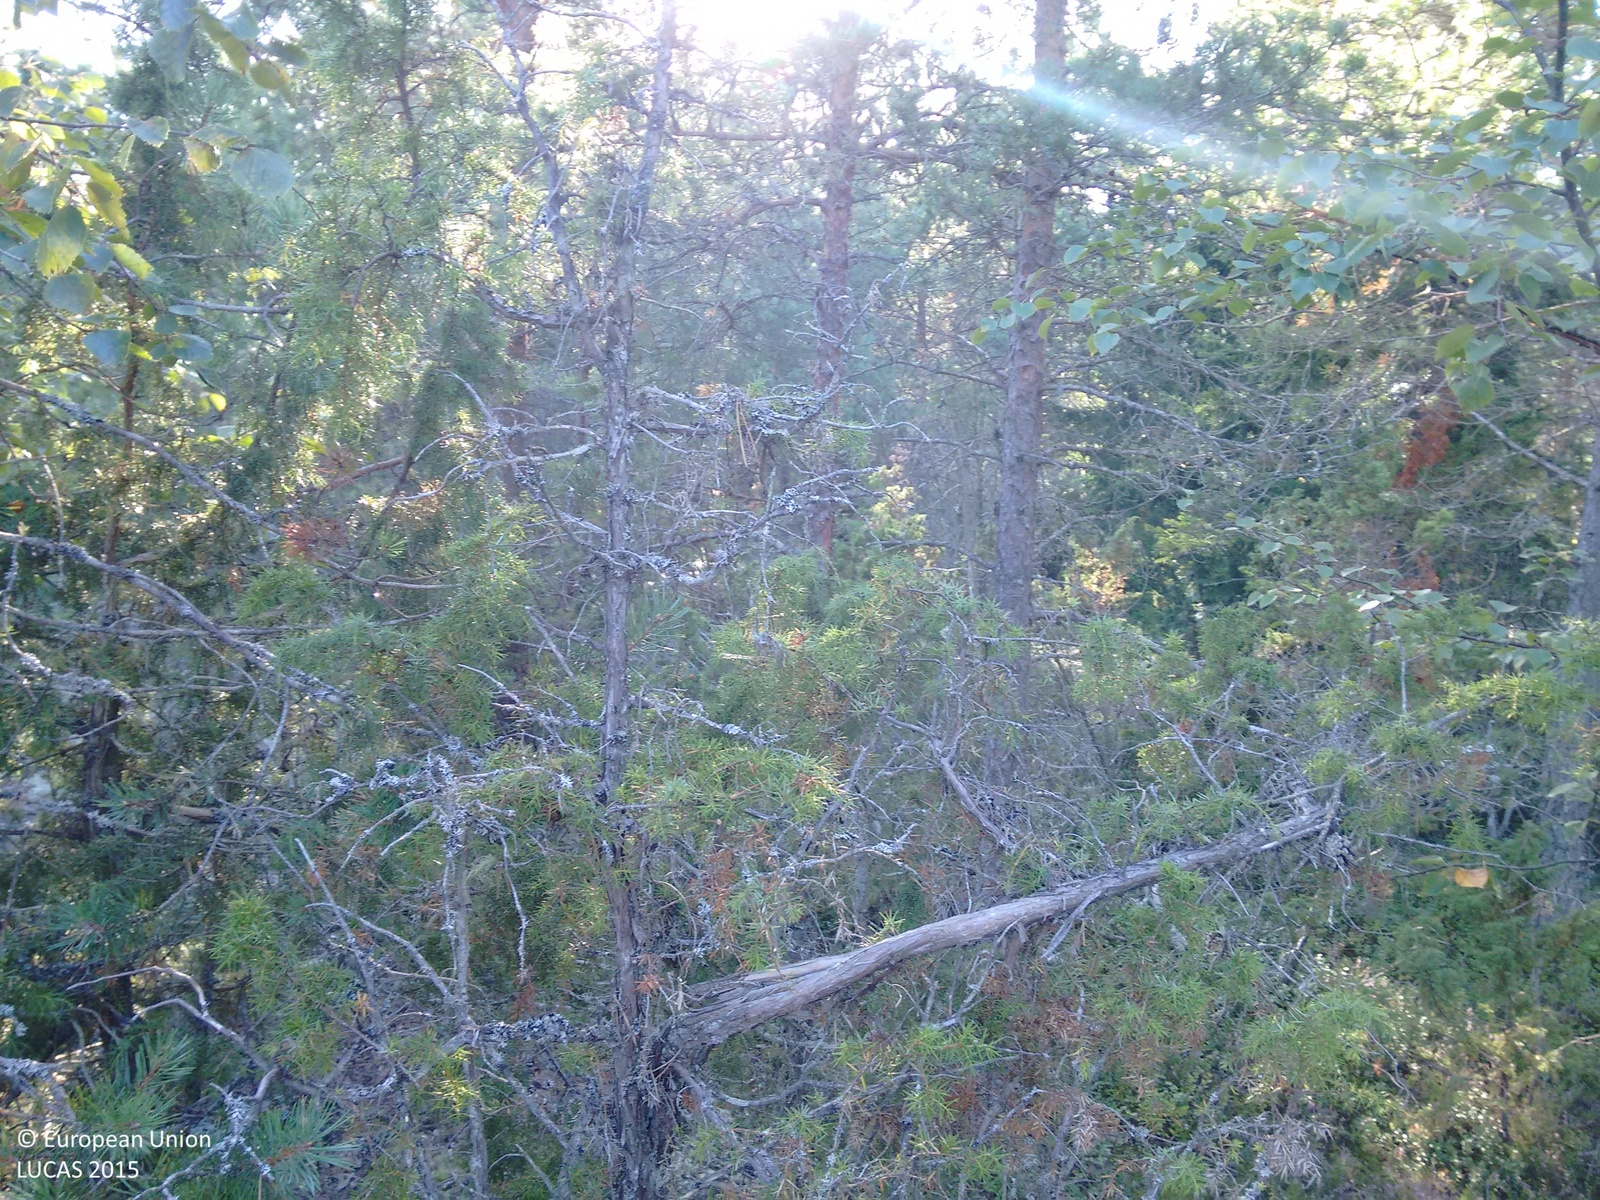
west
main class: Woodland
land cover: Pine dominated coniferous woodland
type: hemiboreal forest and nemoral coniferous forest and mixed broadleaved-coniferous forest
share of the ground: > 75 %
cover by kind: coniferous forest trees 70 %, broadleaved forest trees 15 %, lichens and mosses 10 %, unconsolidated bare surface 5 %
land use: Amenities, museums, leisure
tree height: > 5 m
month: August
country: FI
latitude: 60.1741
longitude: 19.9382
